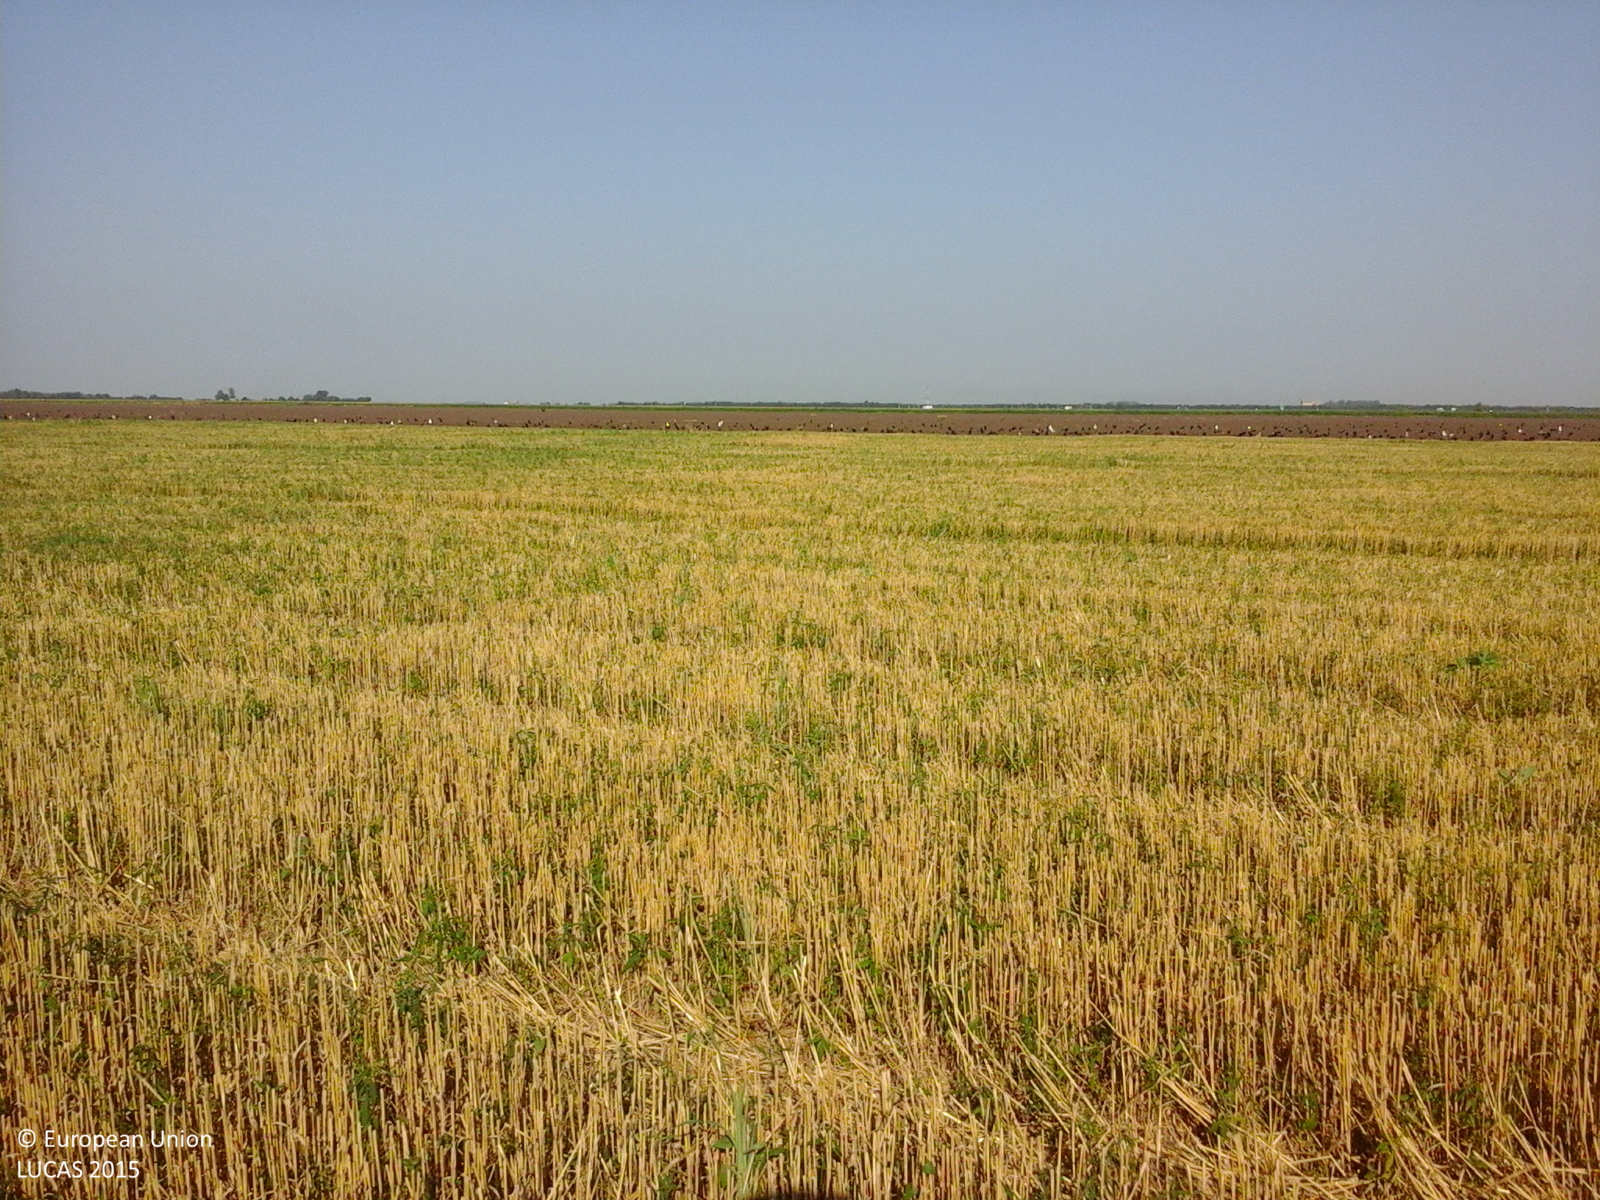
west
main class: Cropland
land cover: Common wheat
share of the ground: > 75 %
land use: Agriculture (excluding fallow land and kitchen gardens)
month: July
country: RO
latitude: 44.4220
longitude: 27.0221
